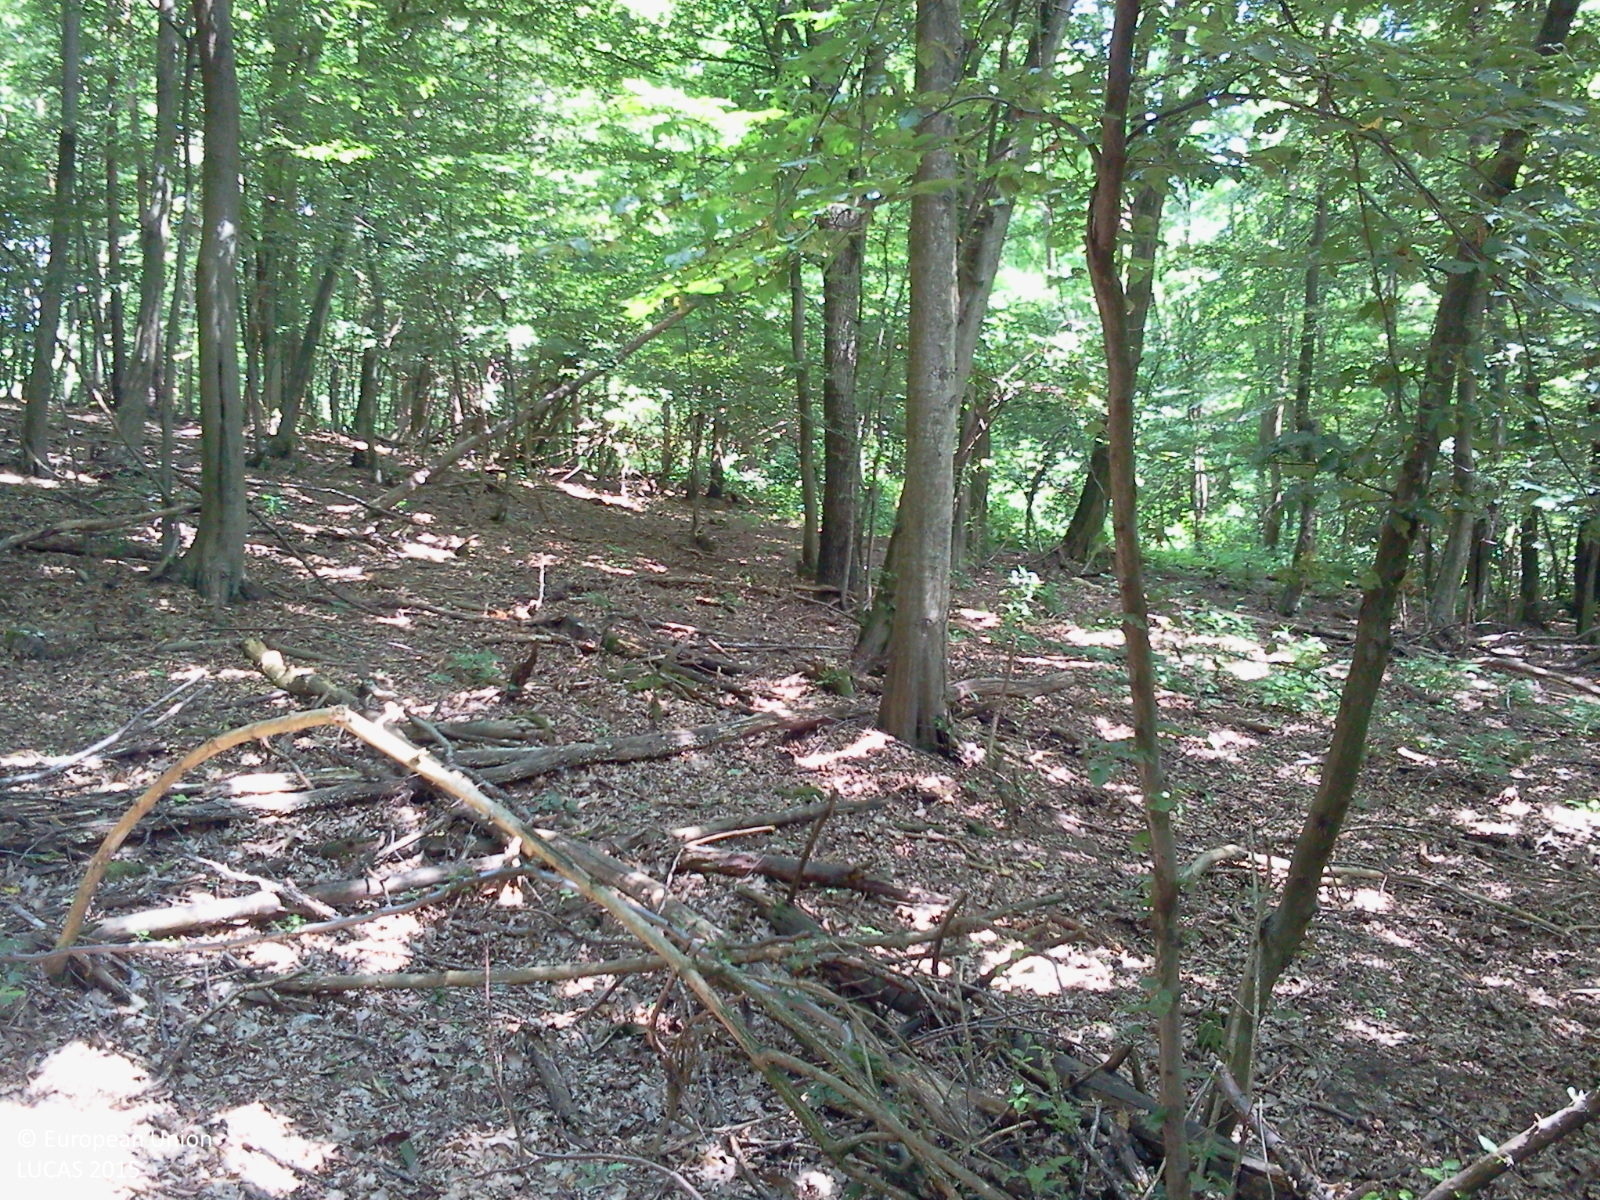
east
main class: Woodland
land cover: Broadleaved woodland
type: thermophilous deciduous forest
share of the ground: > 75 %
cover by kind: broadleaved forest trees 95 %, unconsolidated bare surface 5 %
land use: Forestry
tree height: > 5 m
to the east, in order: Broadleaved woodland; Pine dominated mixed woodland; Ditches and canals; Grass margins; Paved roads, cycling and walking lanes; Broadleaved woodland; Grassland with sparse tree/shrub cover; Grassland without tree/shrub cover; Grassland with sparse tree/shrub cover; Grassland without tree/shrub cover; Broadleaved woodland
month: June
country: HU
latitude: 46.8434
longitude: 17.0194
